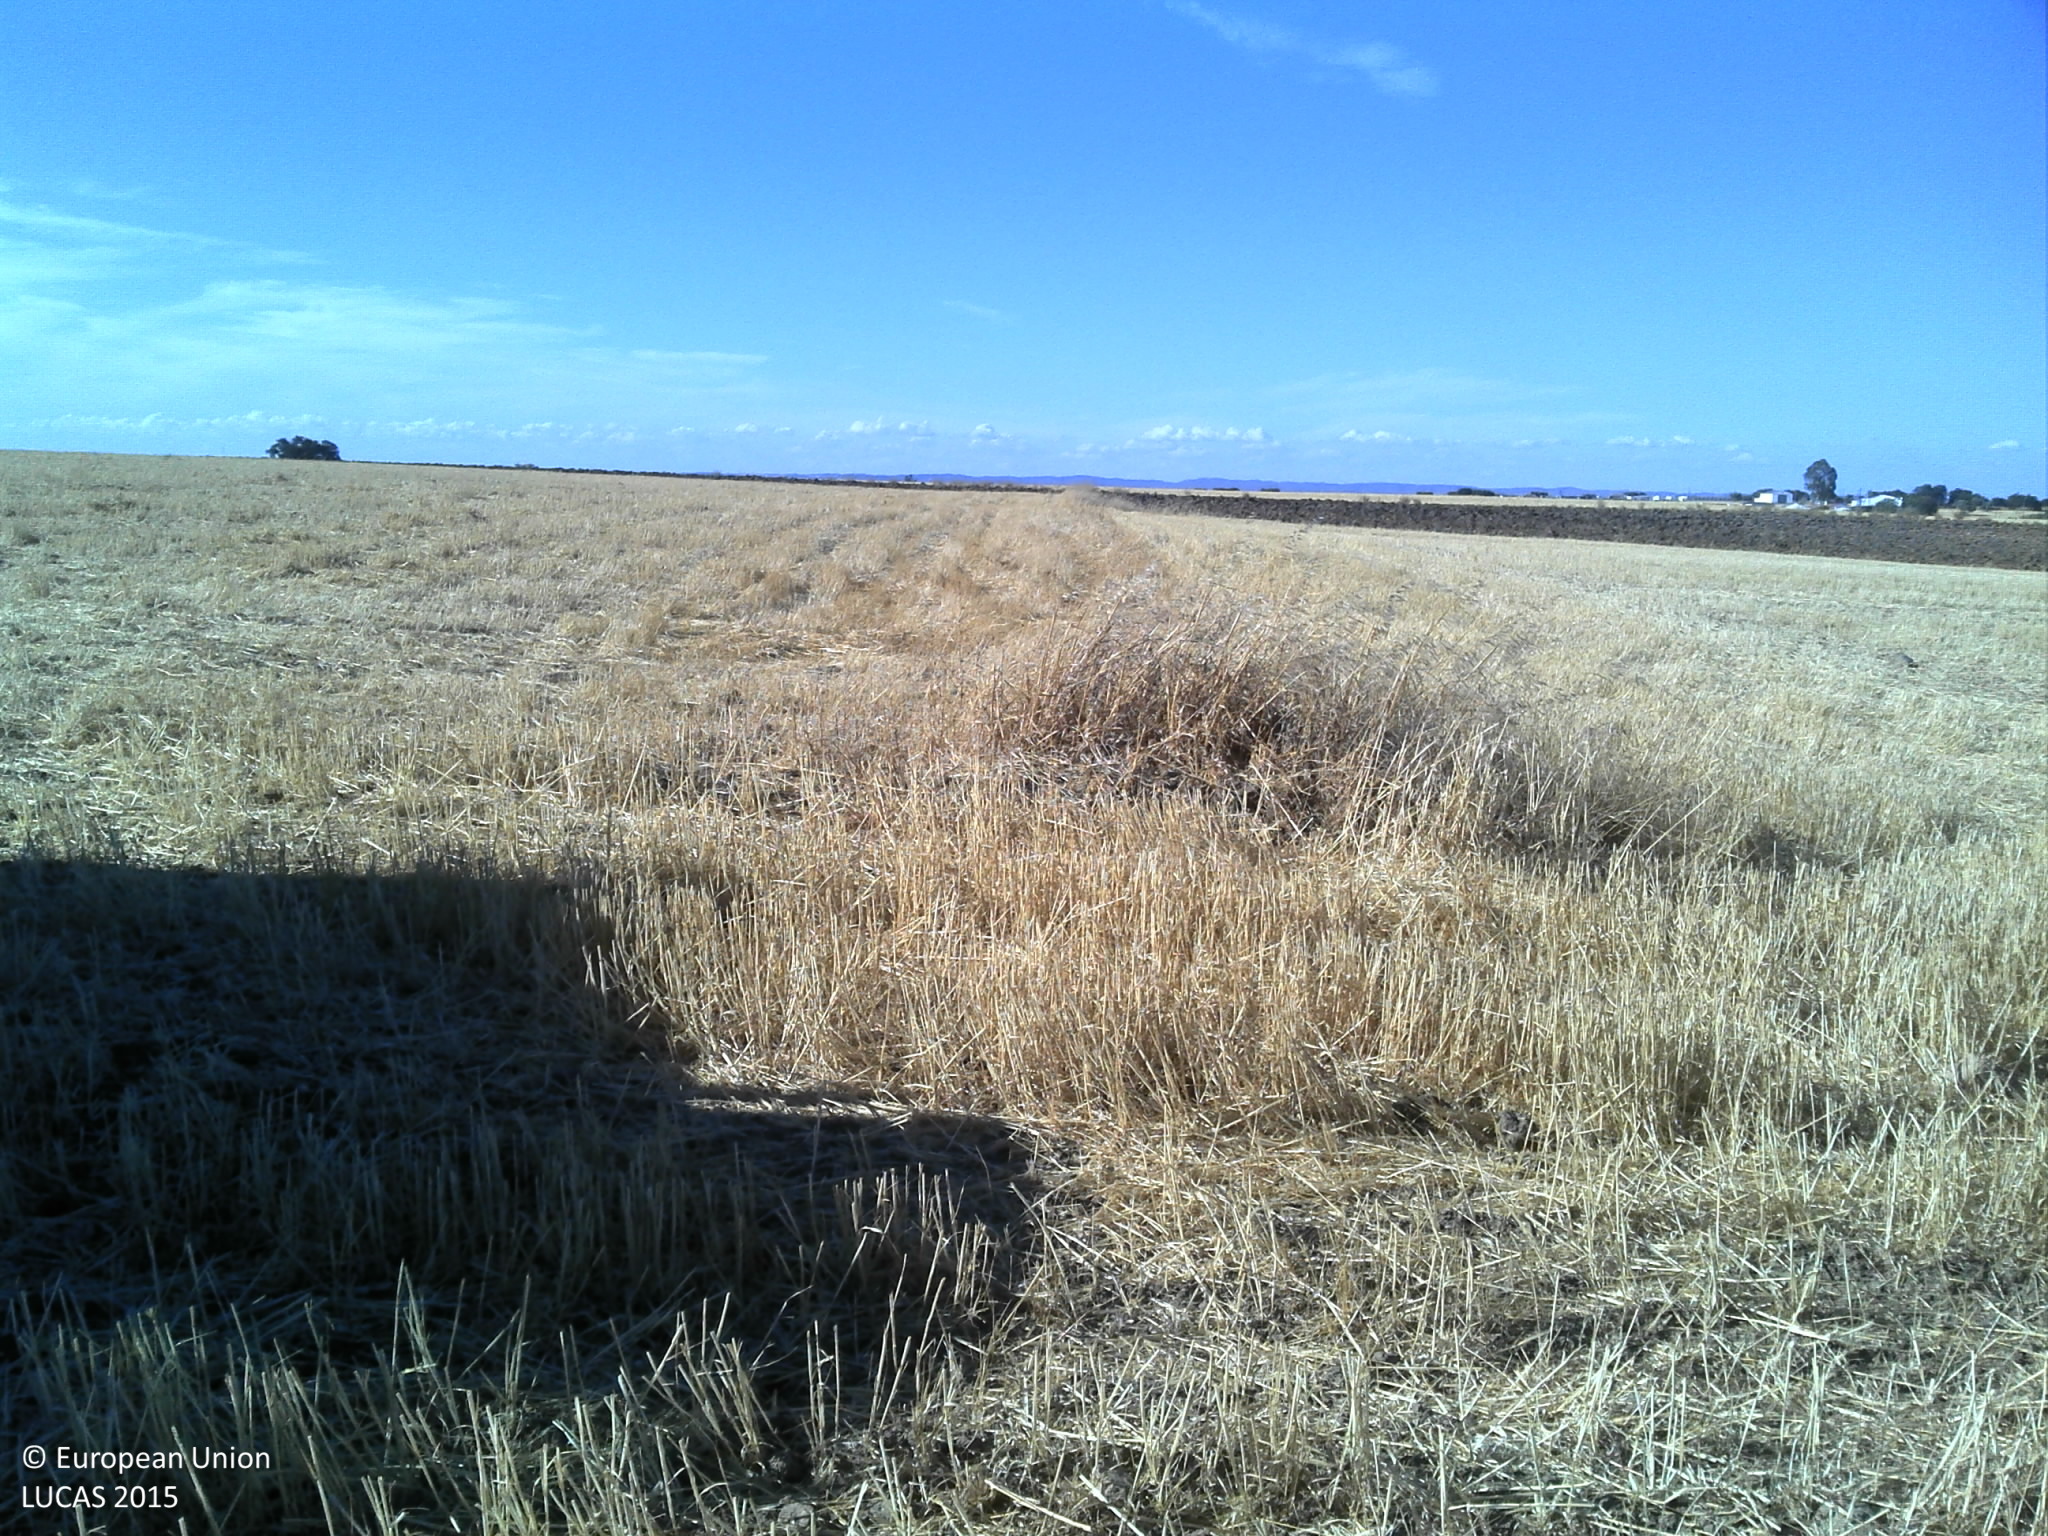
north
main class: Cropland
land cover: Barley
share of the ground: > 75 %
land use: Agriculture (excluding fallow land and kitchen gardens)
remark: Harvested field
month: July
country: PT
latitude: 38.0404
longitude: -7.8601
